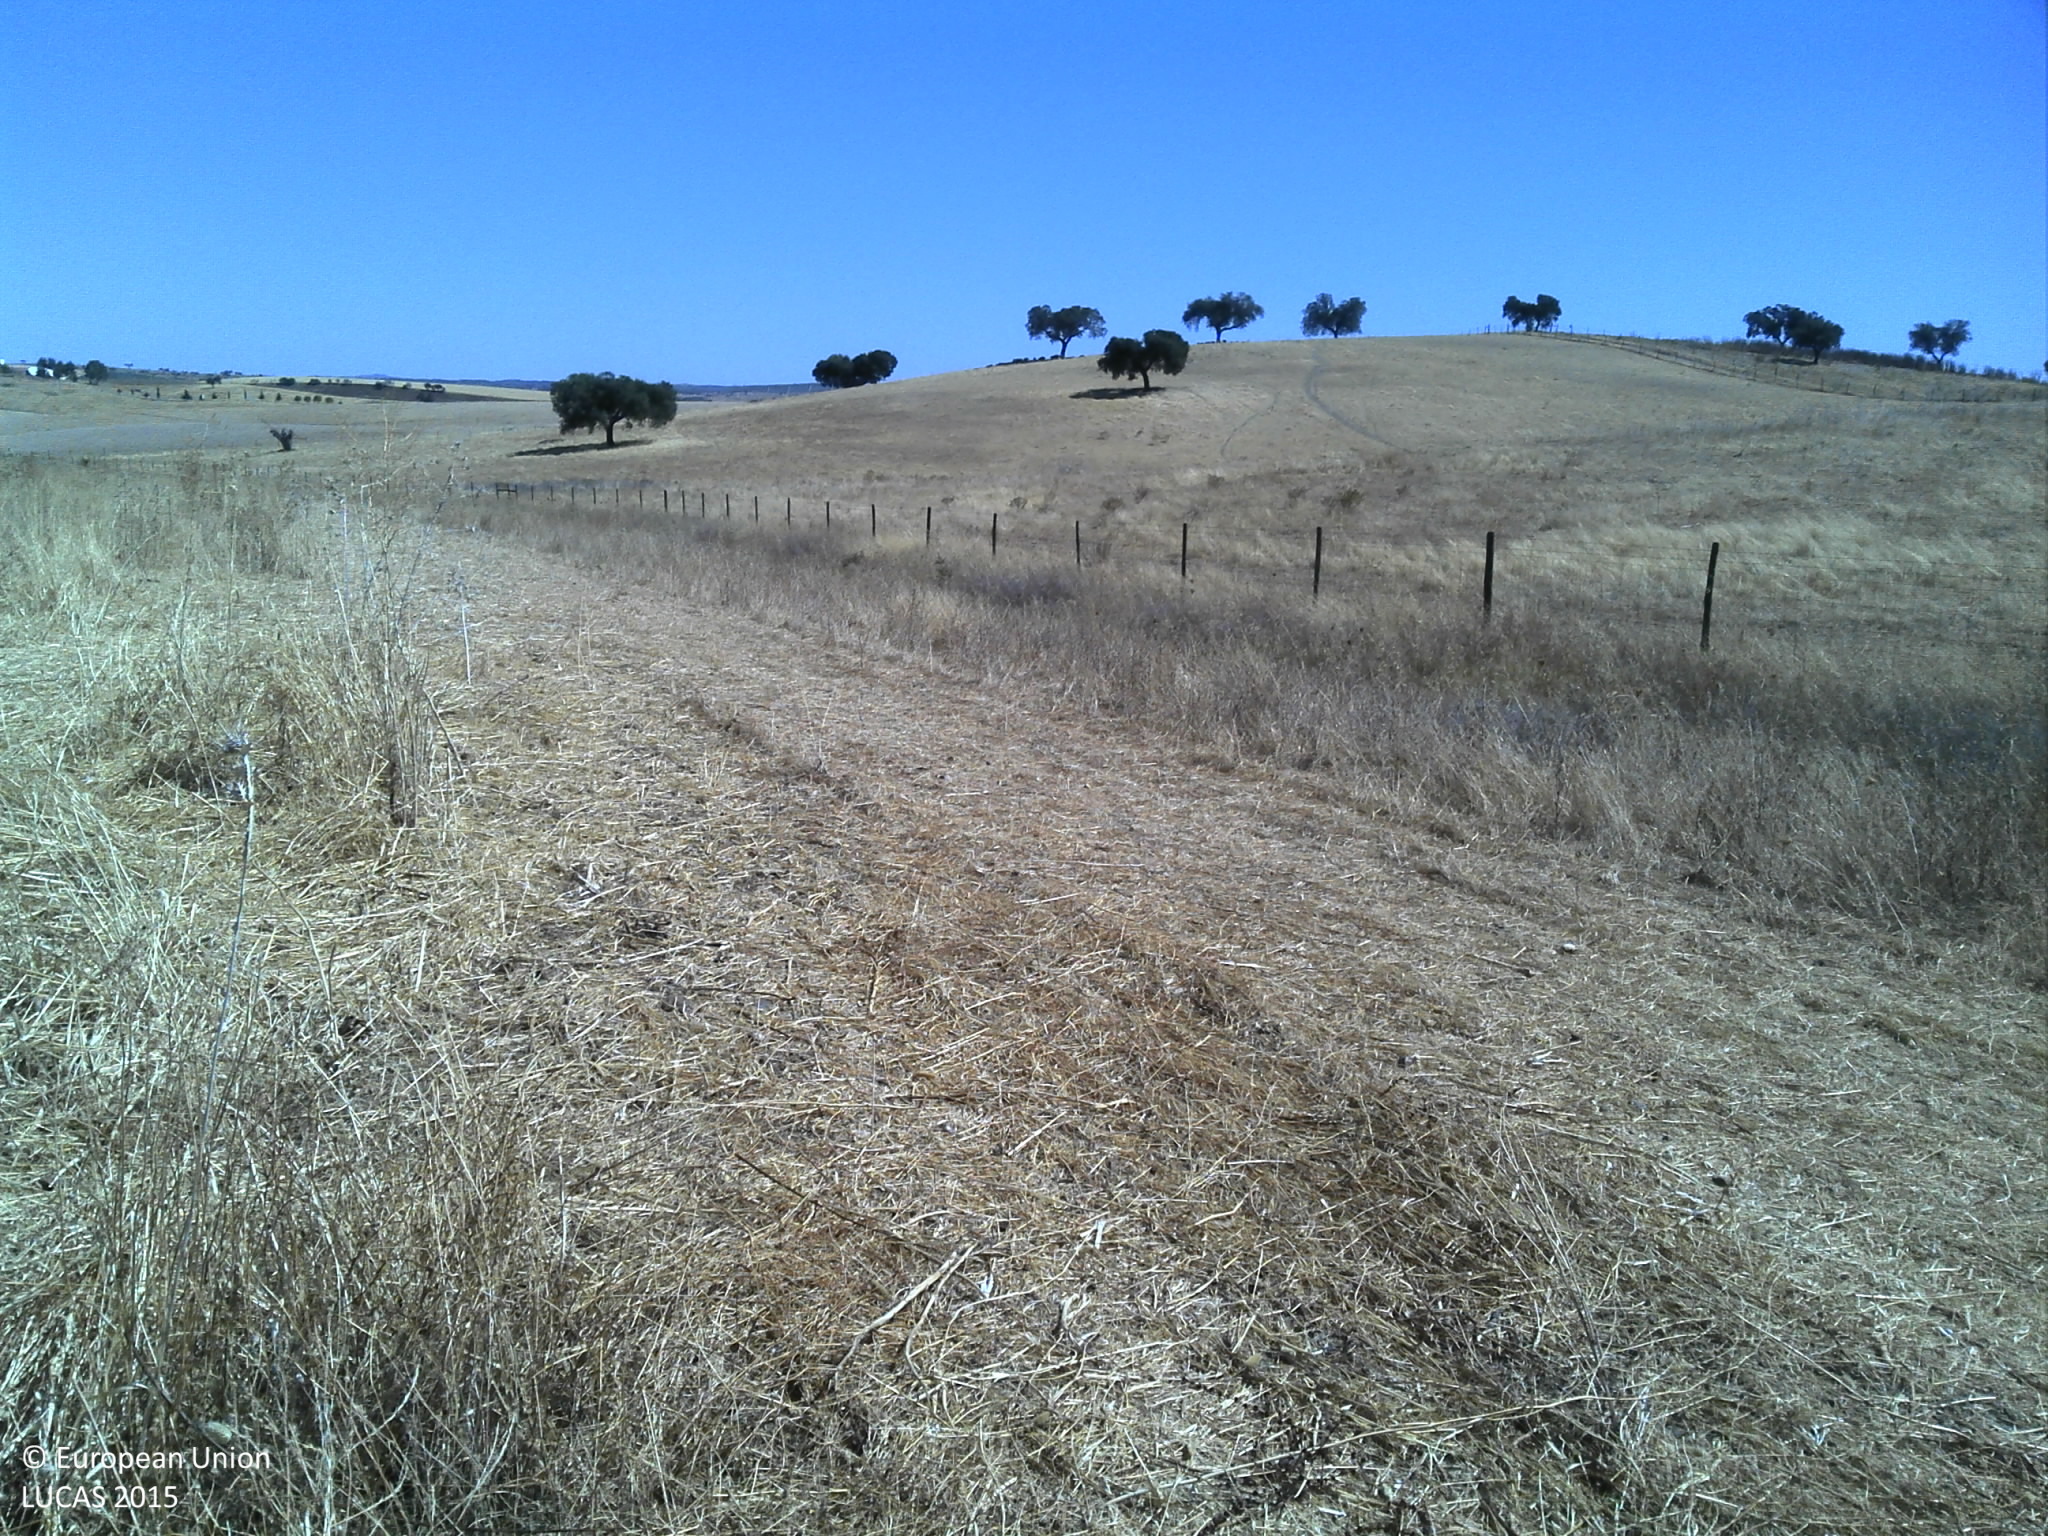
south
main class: Grassland
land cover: Grassland without tree/shrub cover
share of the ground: > 75 %
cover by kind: herbaceous plants 85 %, unconsolidated bare surface 15 %
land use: Agriculture (excluding fallow land and kitchen gardens)
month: July
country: PT
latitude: 38.1577
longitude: -7.7281
